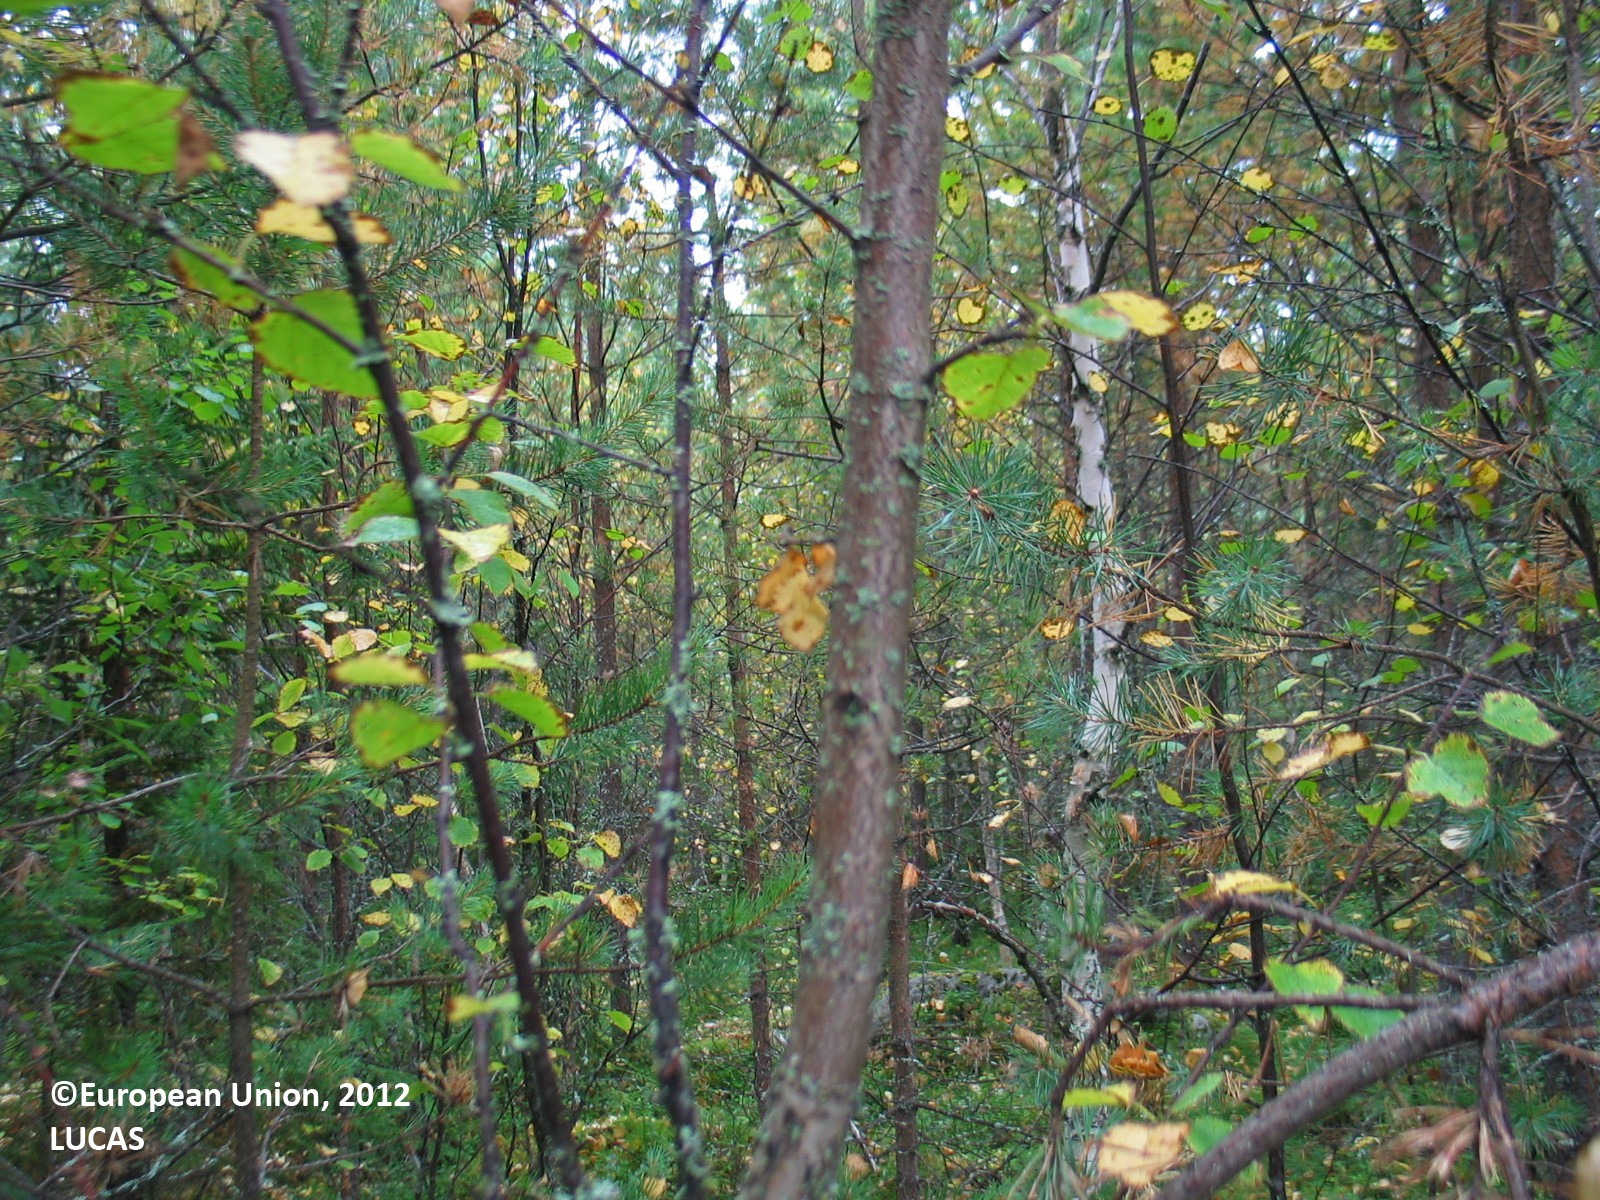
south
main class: Woodland
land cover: Pine dominated mixed woodland
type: boreal forest
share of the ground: 50 - 75 %
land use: Forestry
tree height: > 5 m
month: September
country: FI
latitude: 65.2166
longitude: 25.5396
